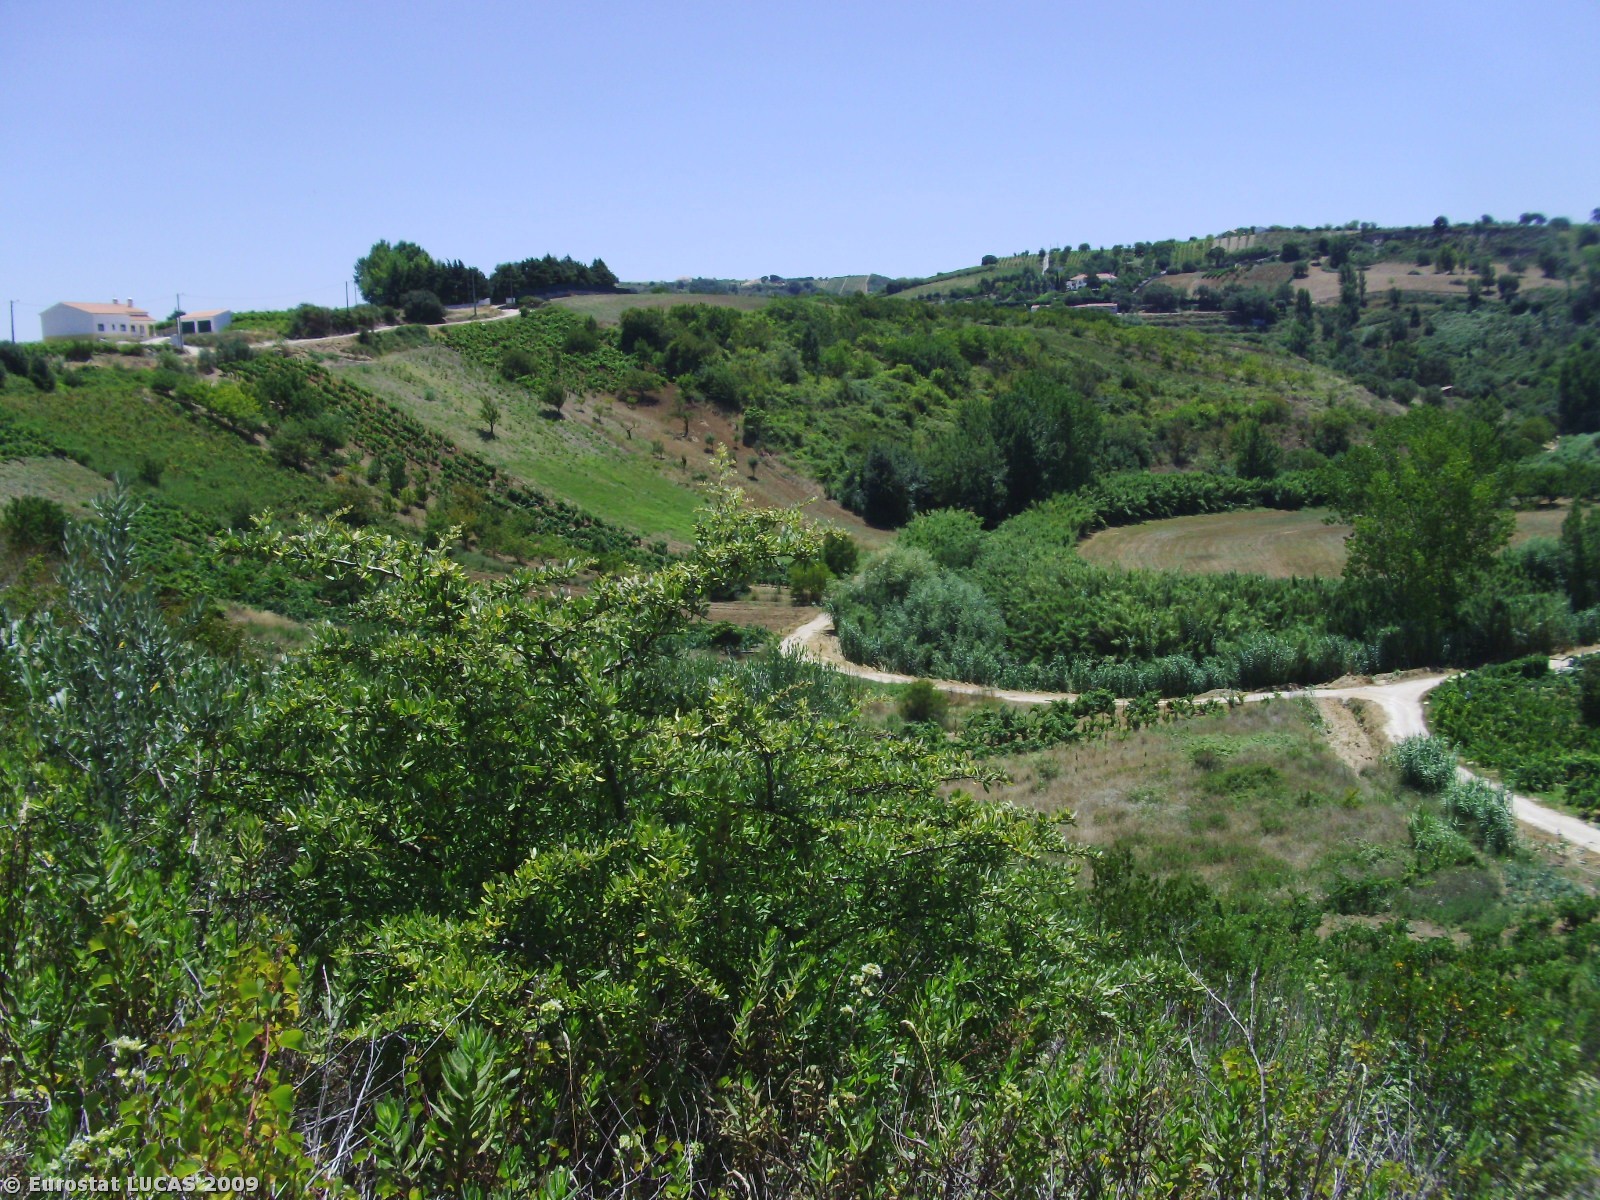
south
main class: Shrubland
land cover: Shrubland without tree cover
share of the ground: > 75 %
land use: Unused
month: July
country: PT
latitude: 39.0851
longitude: -9.0509
